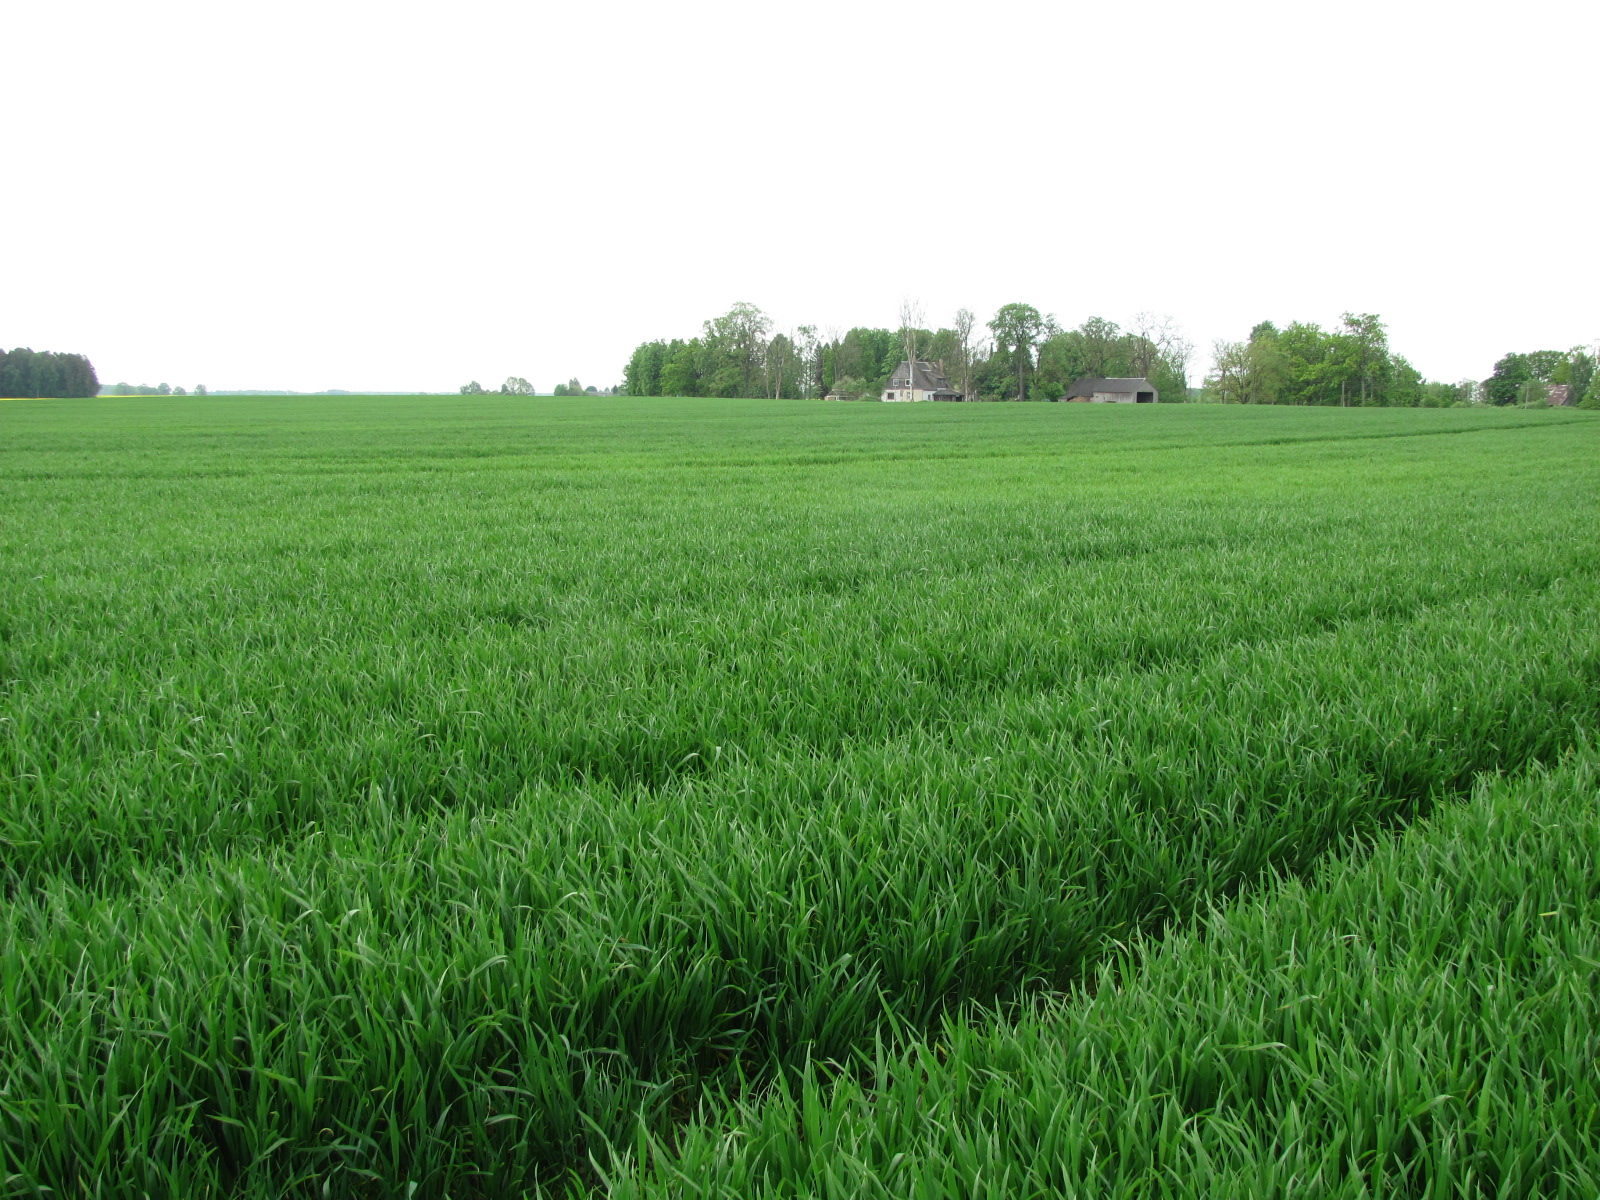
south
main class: Cropland
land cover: Common wheat
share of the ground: > 75 %
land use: Agriculture (excluding fallow land and kitchen gardens)
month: May
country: LV
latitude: 56.4651
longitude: 24.0941
